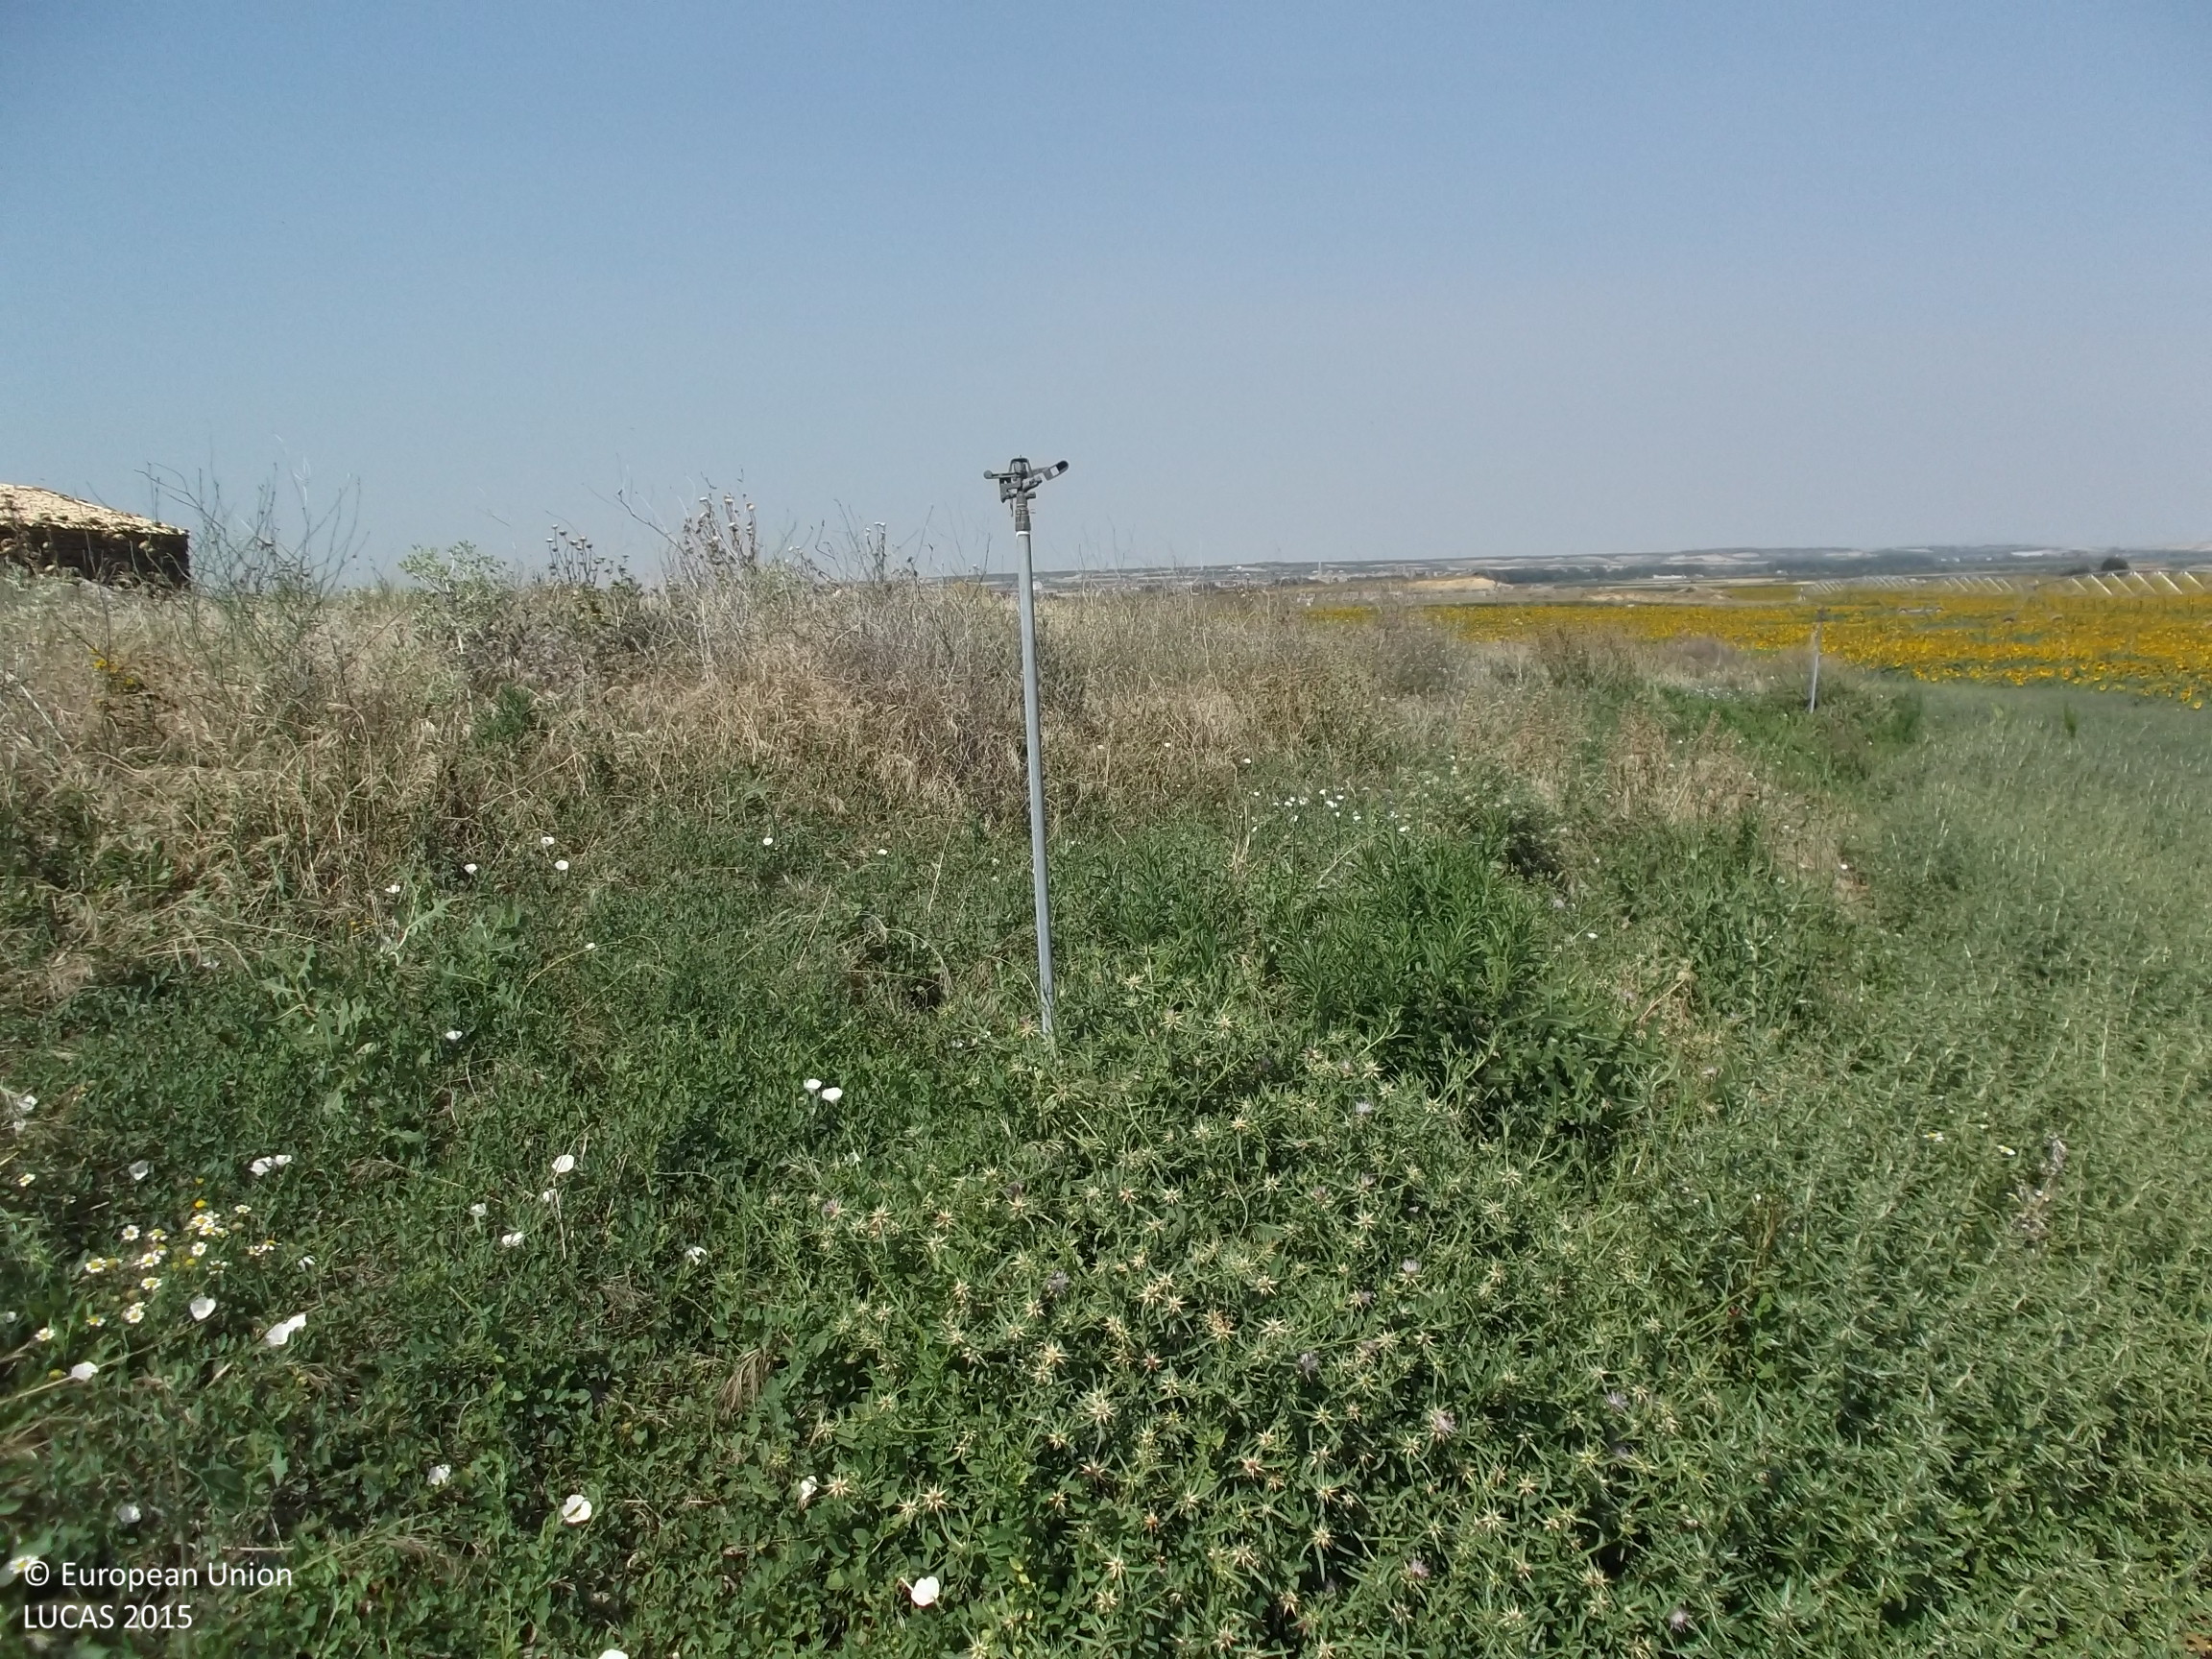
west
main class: Cropland
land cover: Sunflower
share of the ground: > 75 %
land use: Agriculture (excluding fallow land and kitchen gardens)
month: July
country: ES
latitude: 42.4768
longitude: -1.6037
